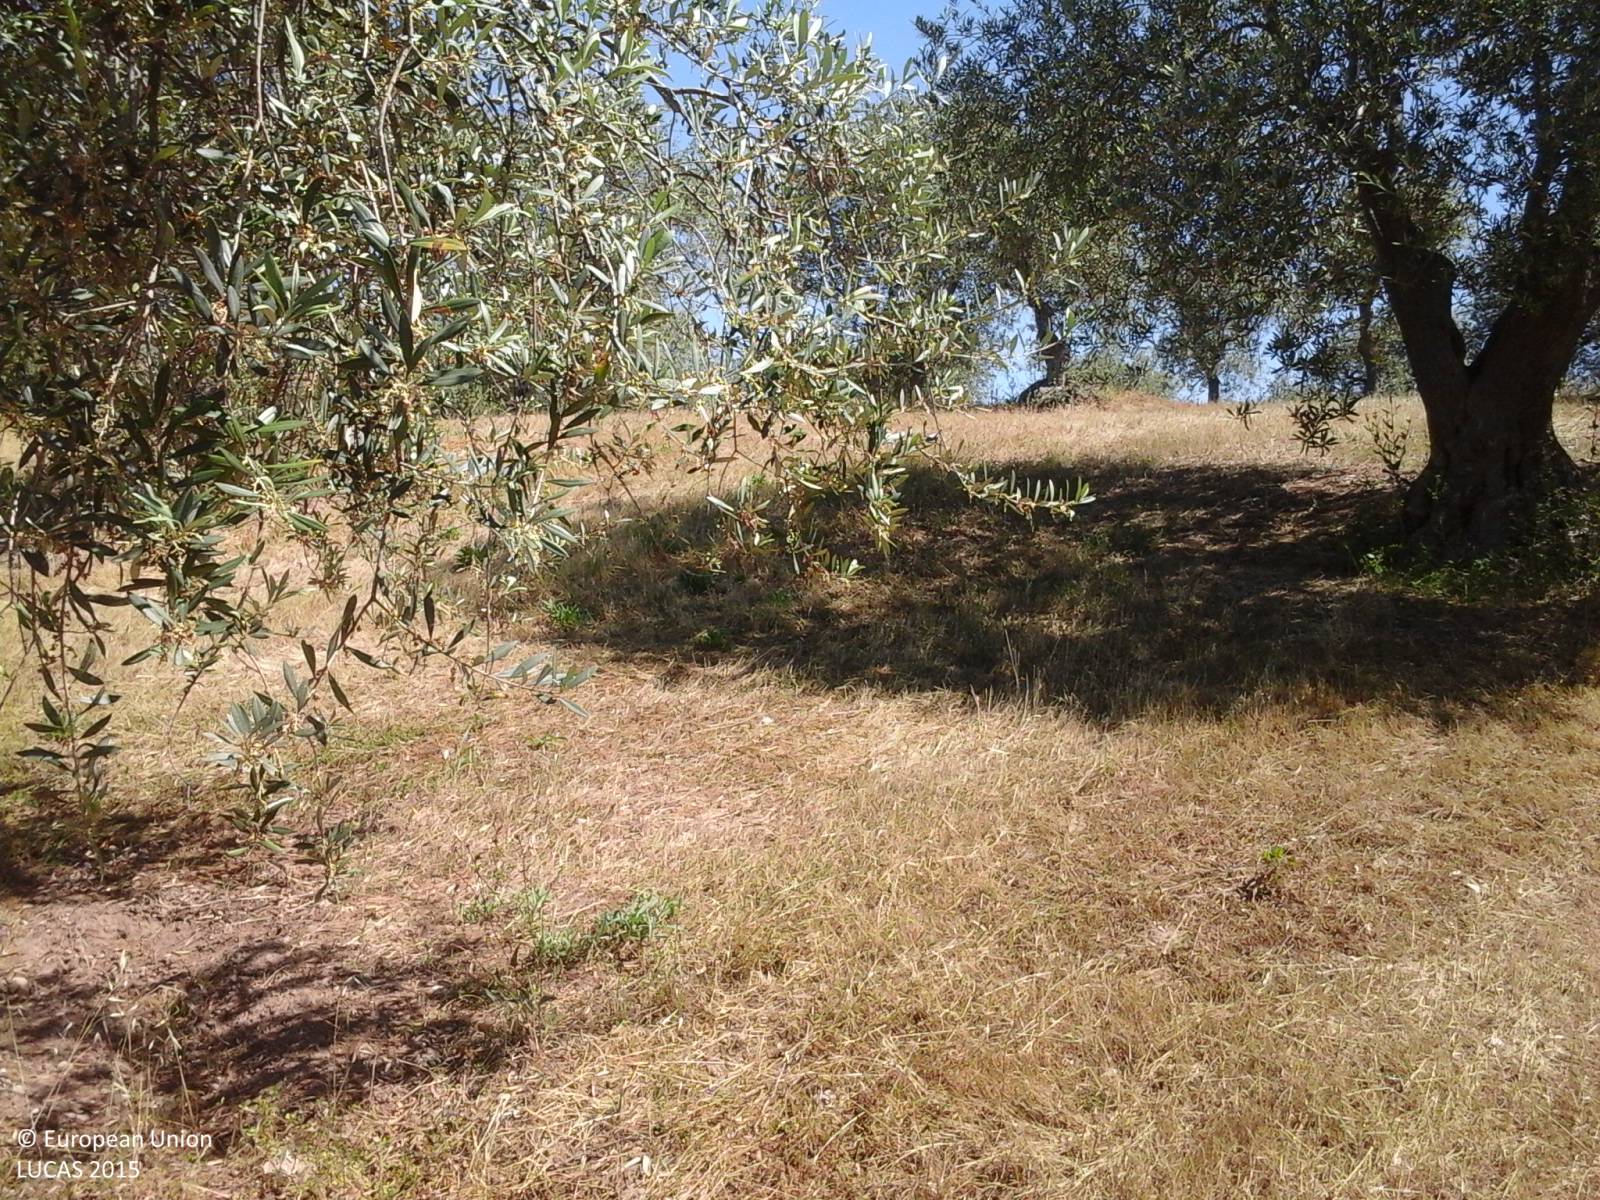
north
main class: Cropland
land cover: Olive groves
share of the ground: 25 - 50 %
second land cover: Spontaneously vegetated surfaces
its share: 50 - 75 %
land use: Agriculture (excluding fallow land and kitchen gardens)
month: May
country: IT
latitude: 40.6538
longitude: 8.4817
